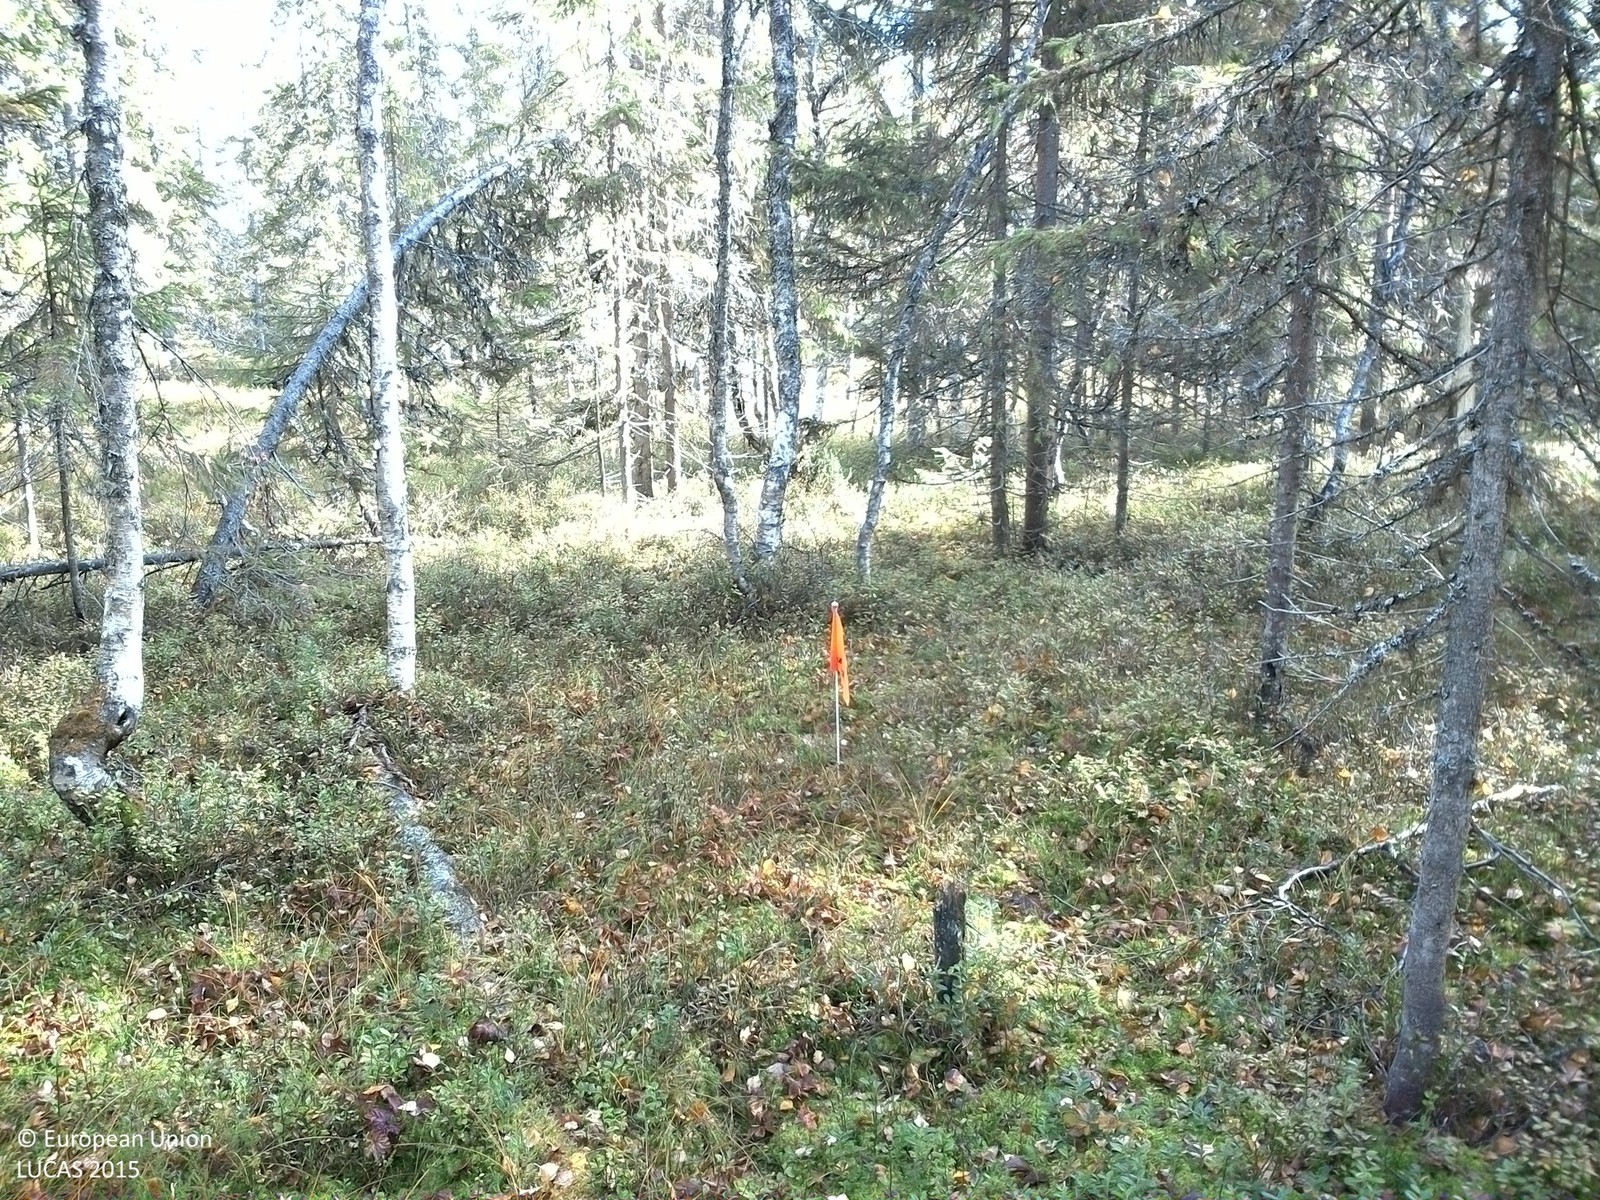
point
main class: Woodland
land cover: Spruce dominated mixed woodland
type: boreal forest
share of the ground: 25 - 50 %
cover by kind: coniferous forest trees 30 %, shrubs 30 %, lichens and mosses 25 %, broadleaved forest trees 15 %
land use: Forestry
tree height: > 5 m
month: October
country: SE
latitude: 61.3779
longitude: 14.8692
